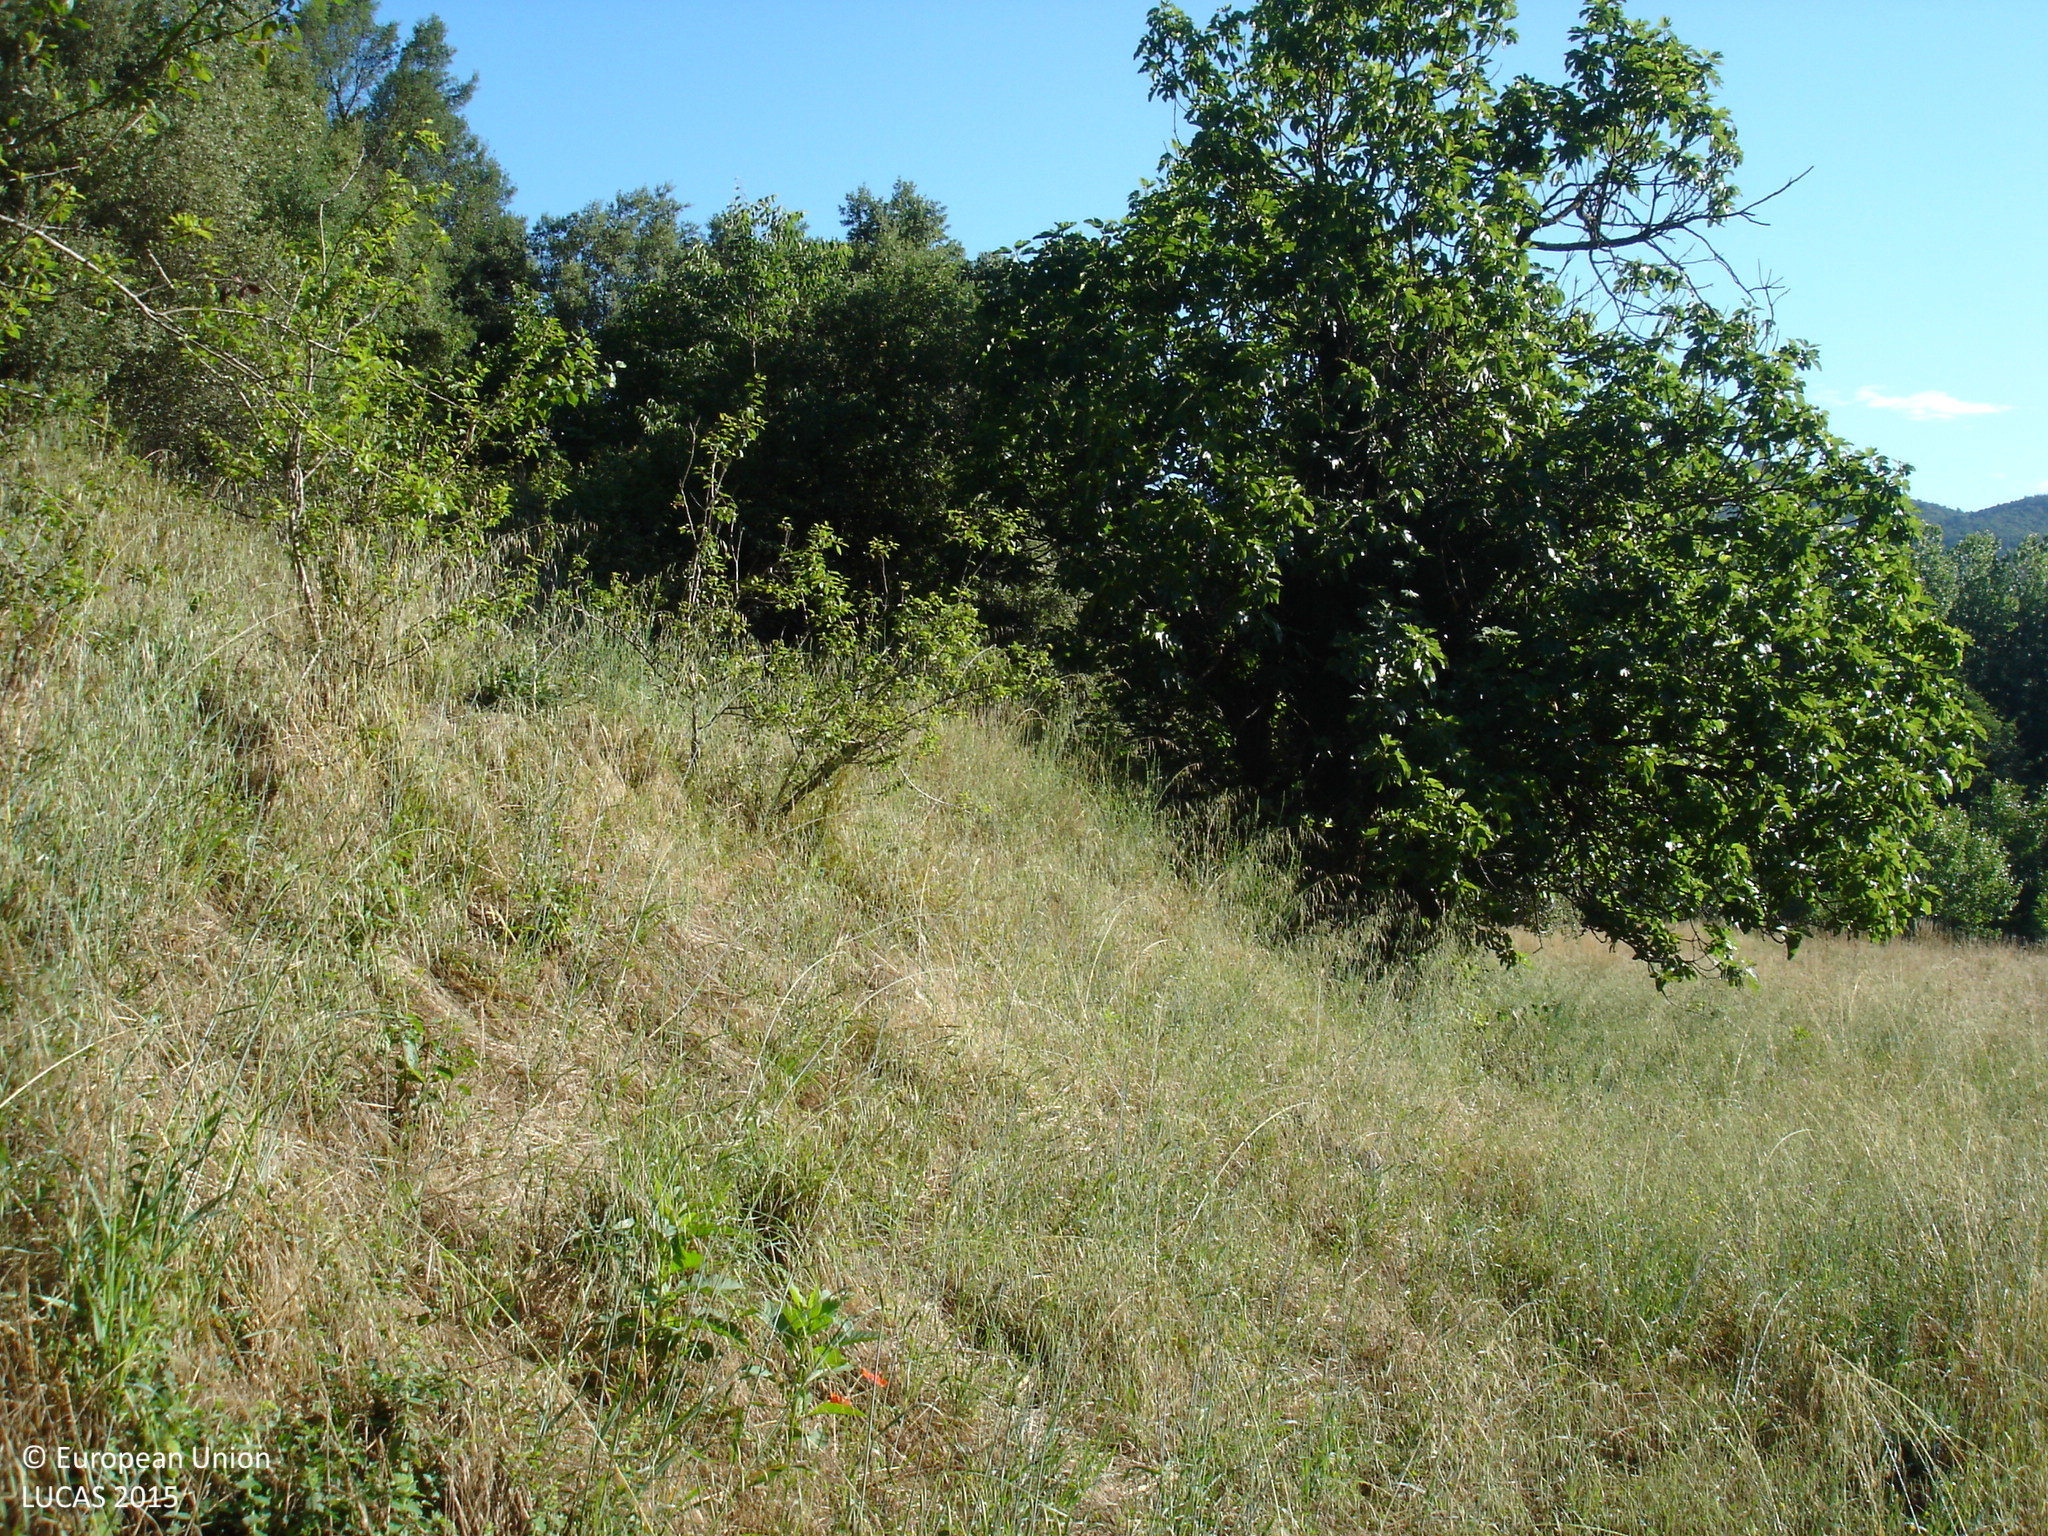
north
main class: Grassland
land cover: Spontaneously vegetated surfaces
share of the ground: > 75 %
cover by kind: herbaceous plants 95 %, shrubs 5 %
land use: Fallow land
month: June
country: ES
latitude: 41.7985
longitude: 2.5425
